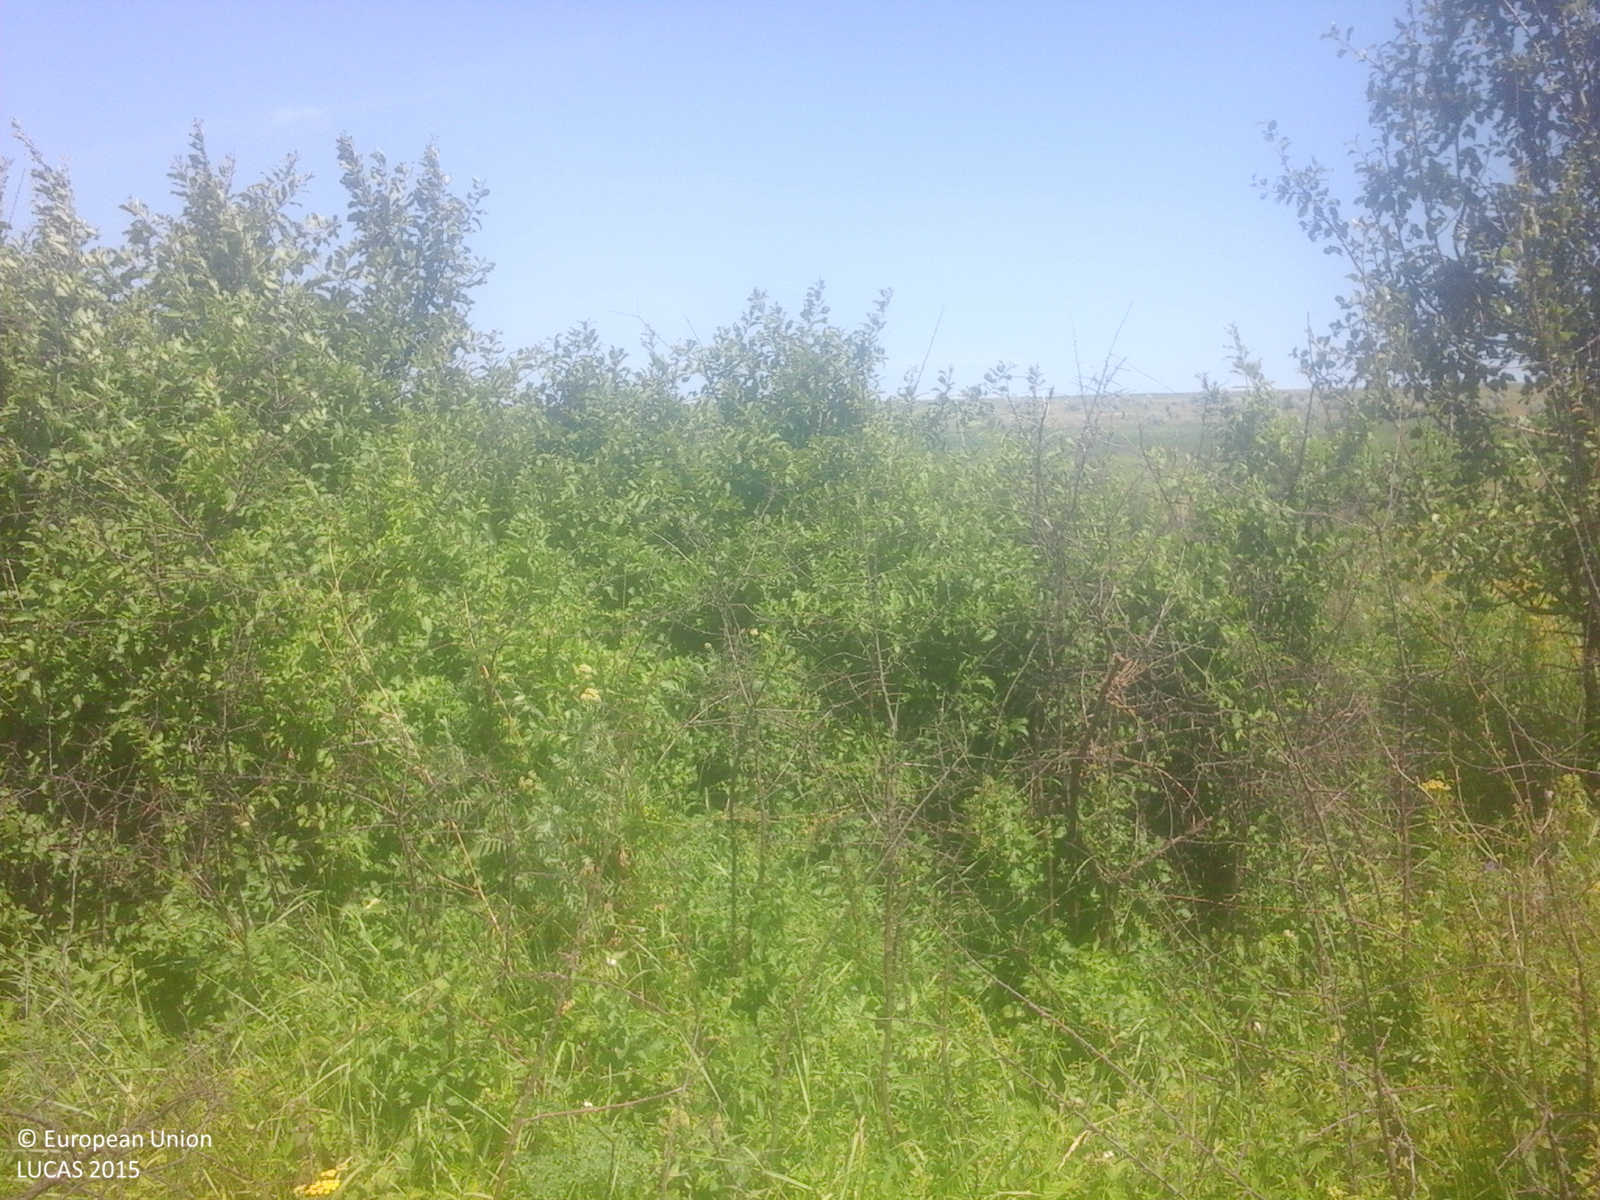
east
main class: Shrubland
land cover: Shrubland without tree cover
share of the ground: > 75 %
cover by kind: shrubs 80 %, herbaceous plants 20 %
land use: Semi-natural and natural areas not in use
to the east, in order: Shrubland without tree cover; Spontaneously vegetated surfaces; Maize
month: June
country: RO
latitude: 47.9176
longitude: 26.8965
